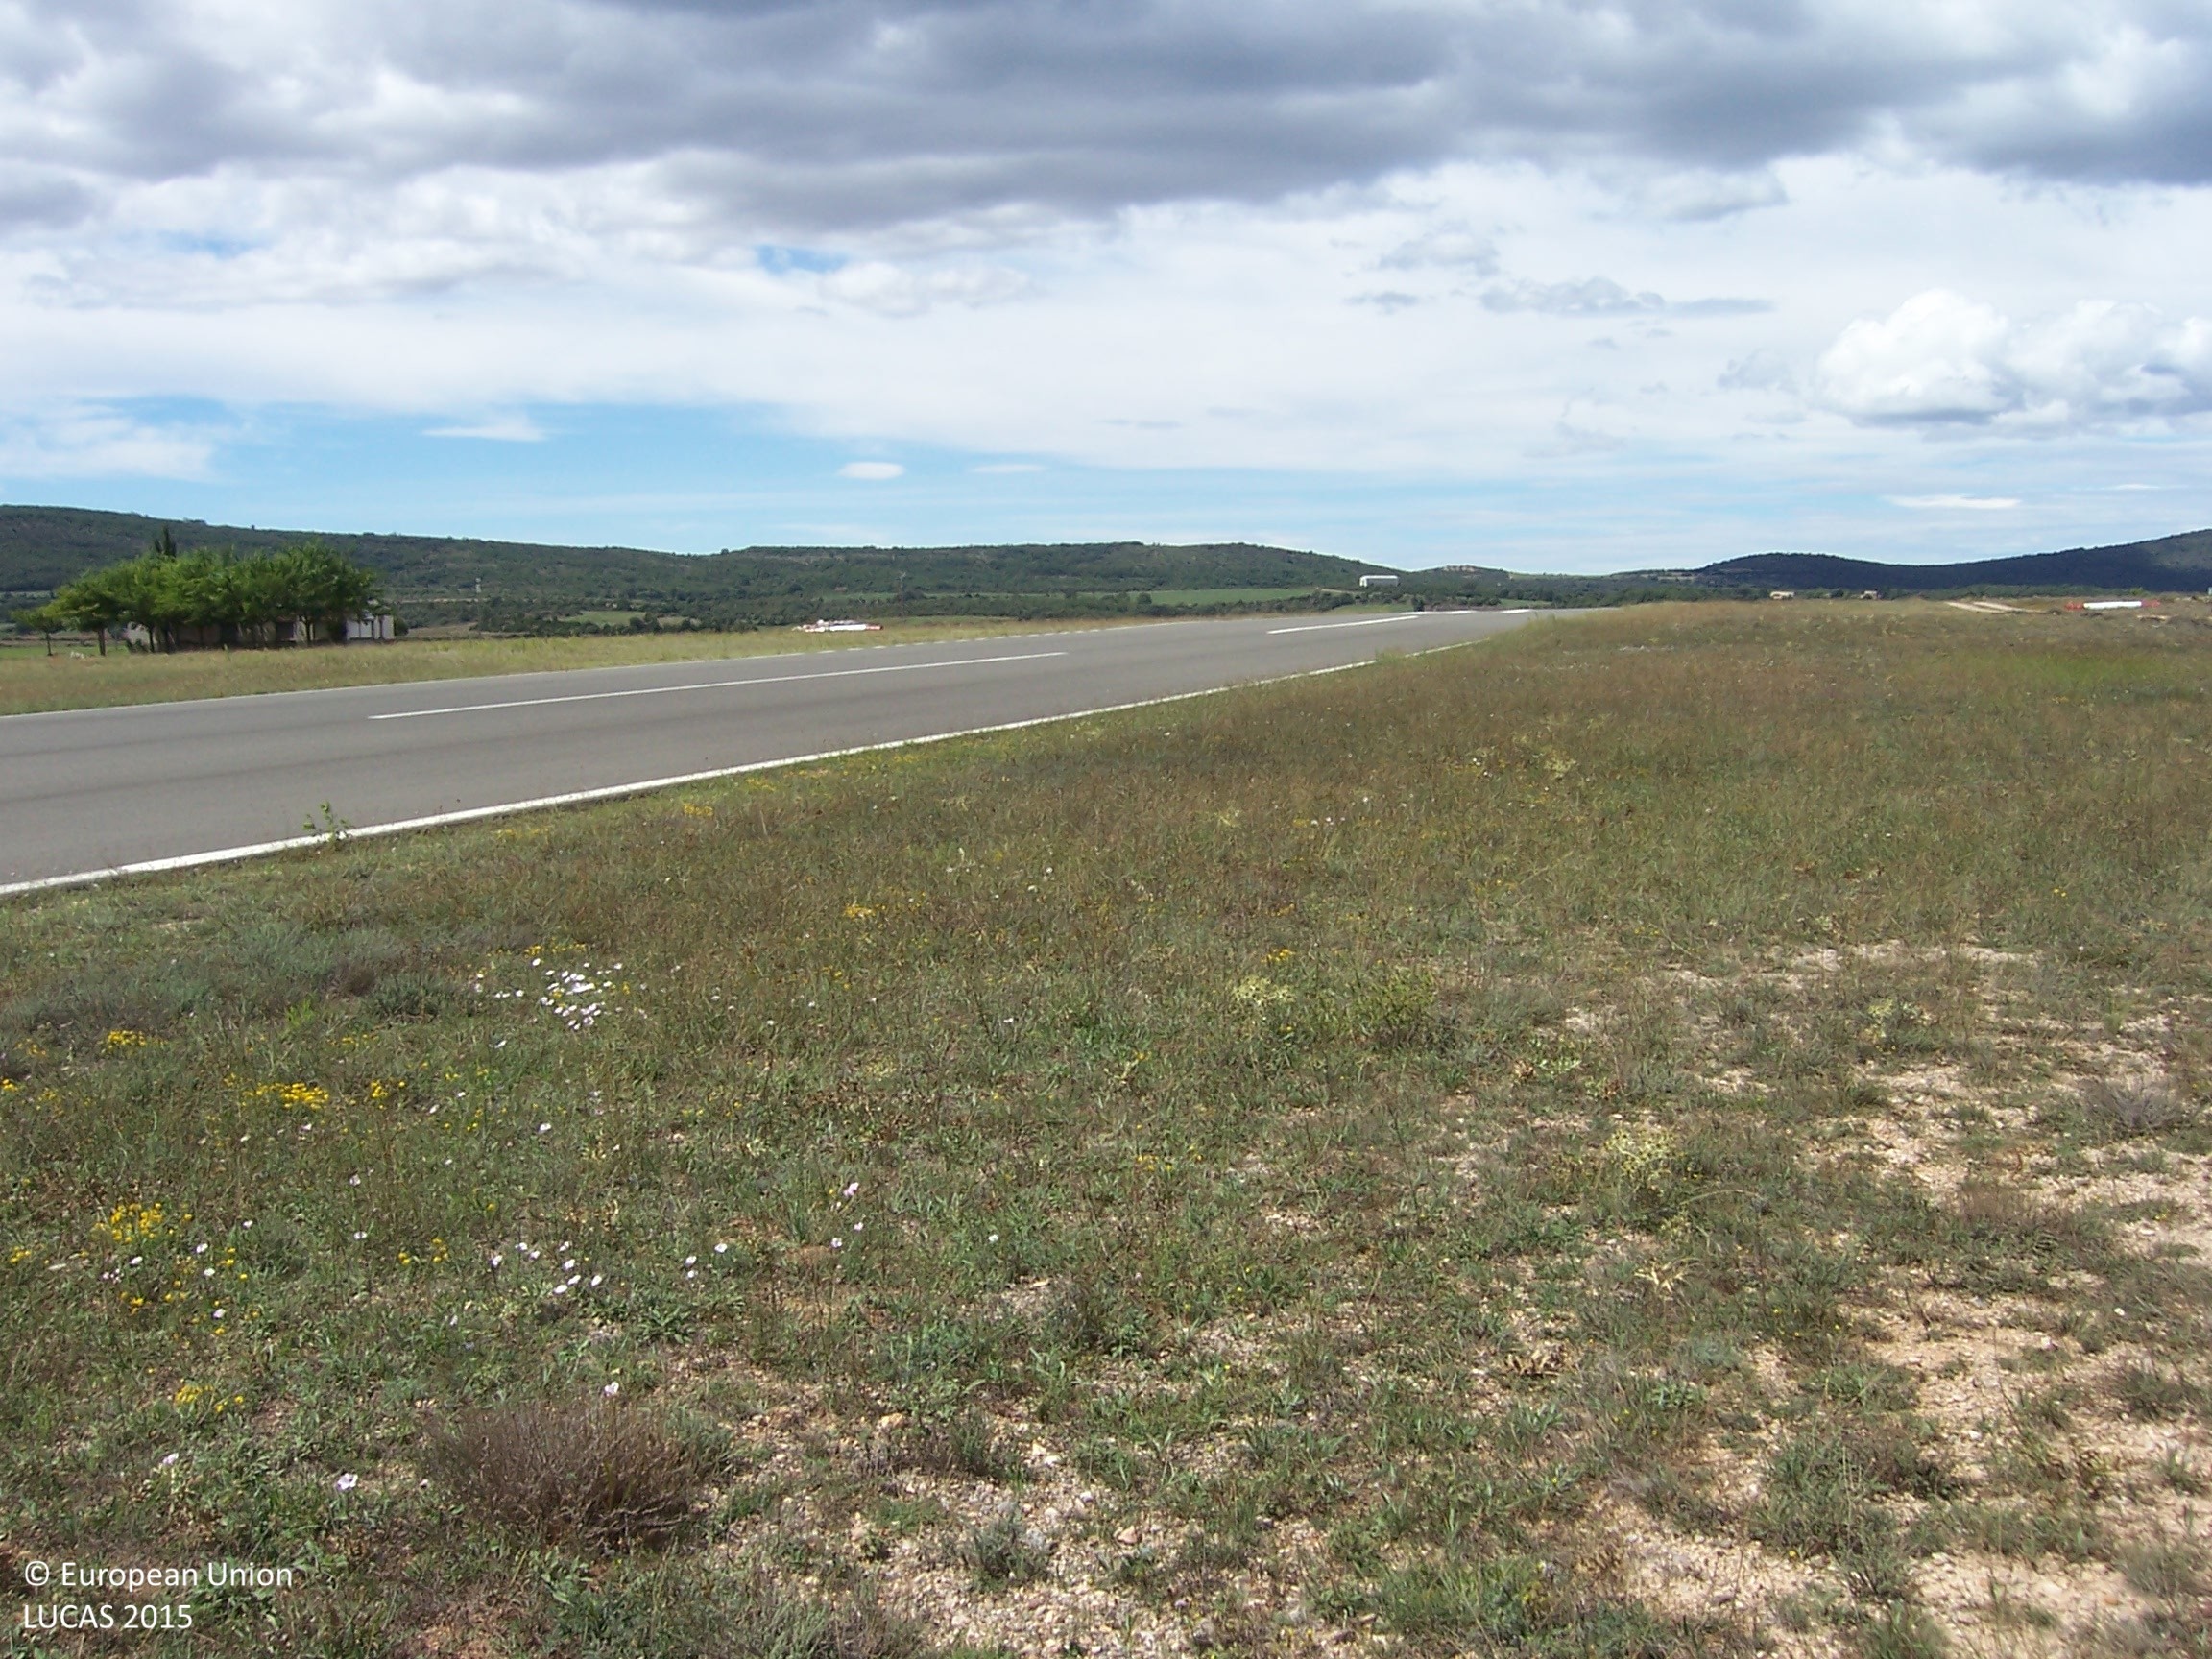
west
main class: Grassland
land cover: Grassland without tree/shrub cover
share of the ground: > 75 %
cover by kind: herbaceous plants 80 %, unconsolidated bare surface 20 %
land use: Air transport
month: August
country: ES
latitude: 42.0228
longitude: 0.4791
